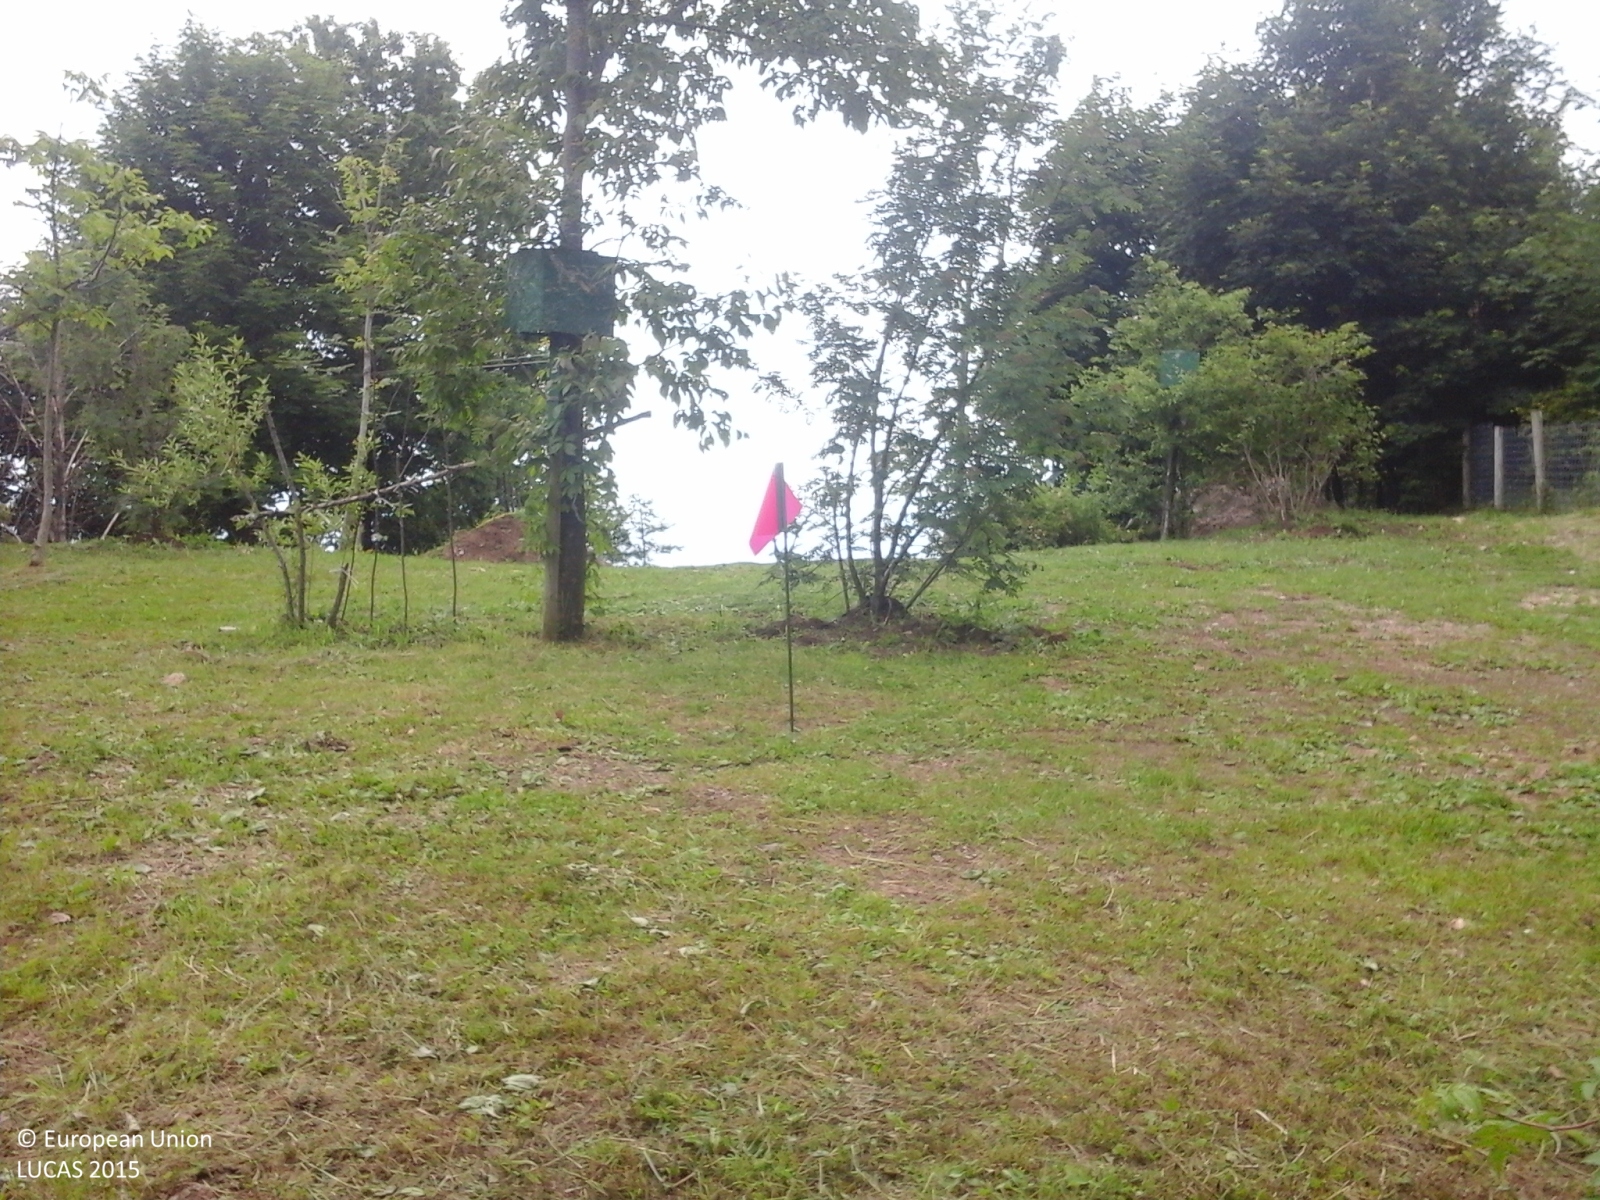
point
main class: Grassland
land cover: Grassland with sparse tree/shrub cover
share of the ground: > 75 %
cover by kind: herbaceous plants 95 %, broadleaved forest trees 5 %
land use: Agriculture (excluding fallow land and kitchen gardens)
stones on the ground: 25 - 50 %
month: June
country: IT
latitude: 45.7994
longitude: 11.5544
